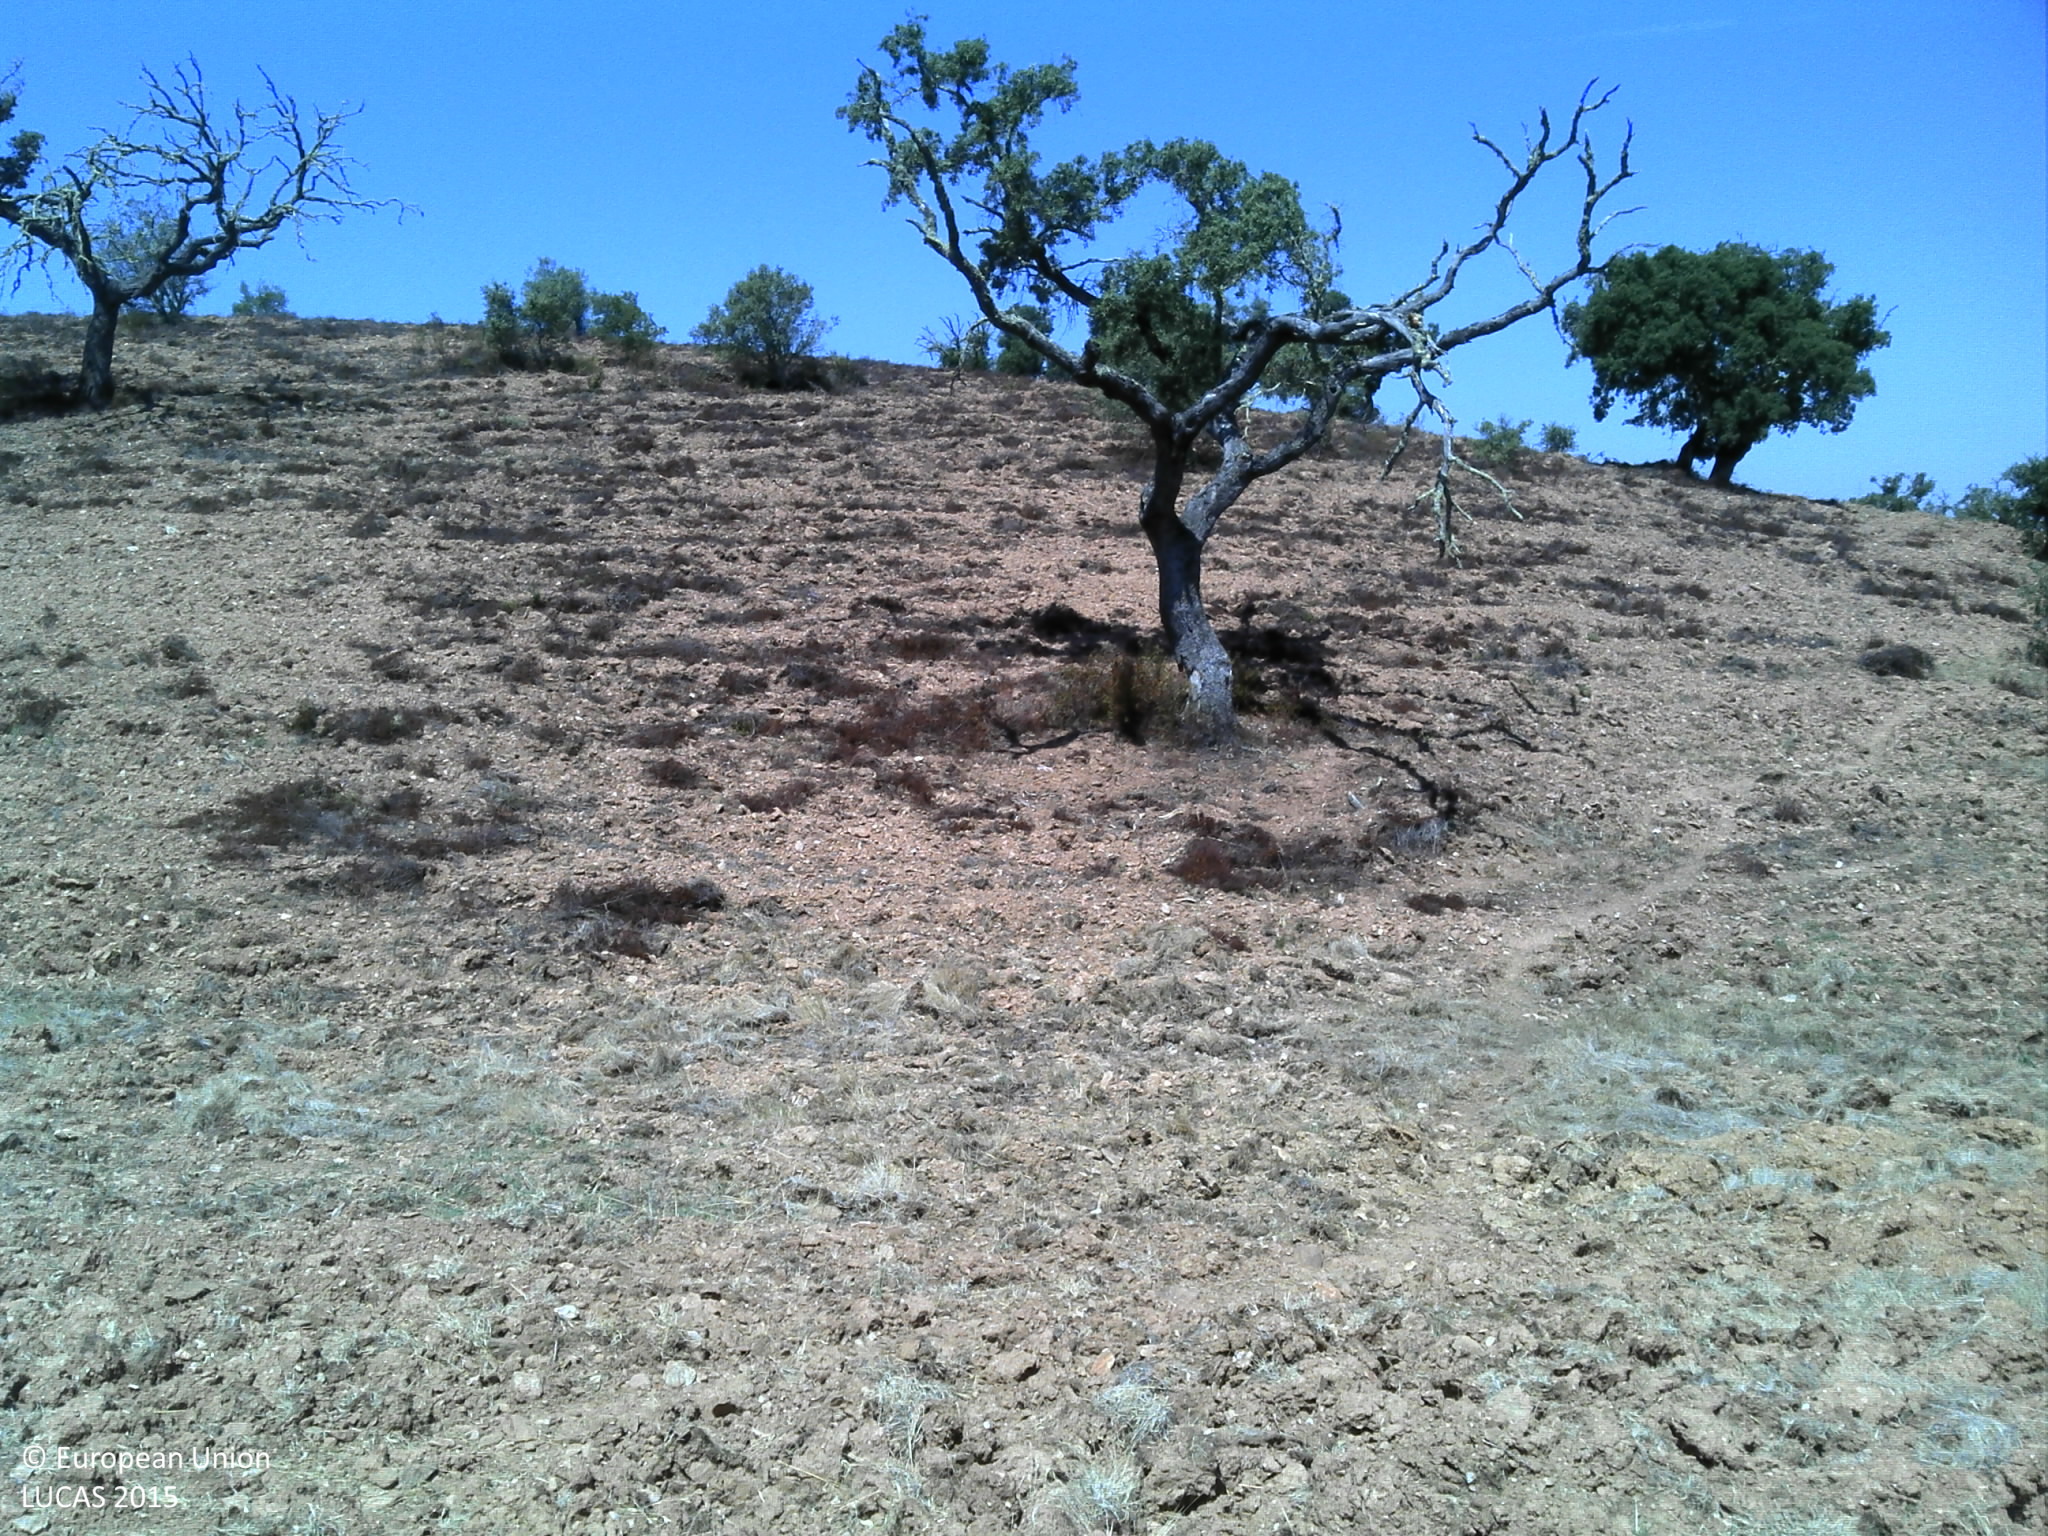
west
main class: Grassland
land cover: Grassland with sparse tree/shrub cover
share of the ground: 10 - 25 %
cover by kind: unconsolidated bare surface 75 %, herbaceous plants 20 %, broadleaved forest trees 5 %
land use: Agriculture (excluding fallow land and kitchen gardens)
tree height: < 5 m
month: June
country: PT
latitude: 37.8481
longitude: -7.5063
